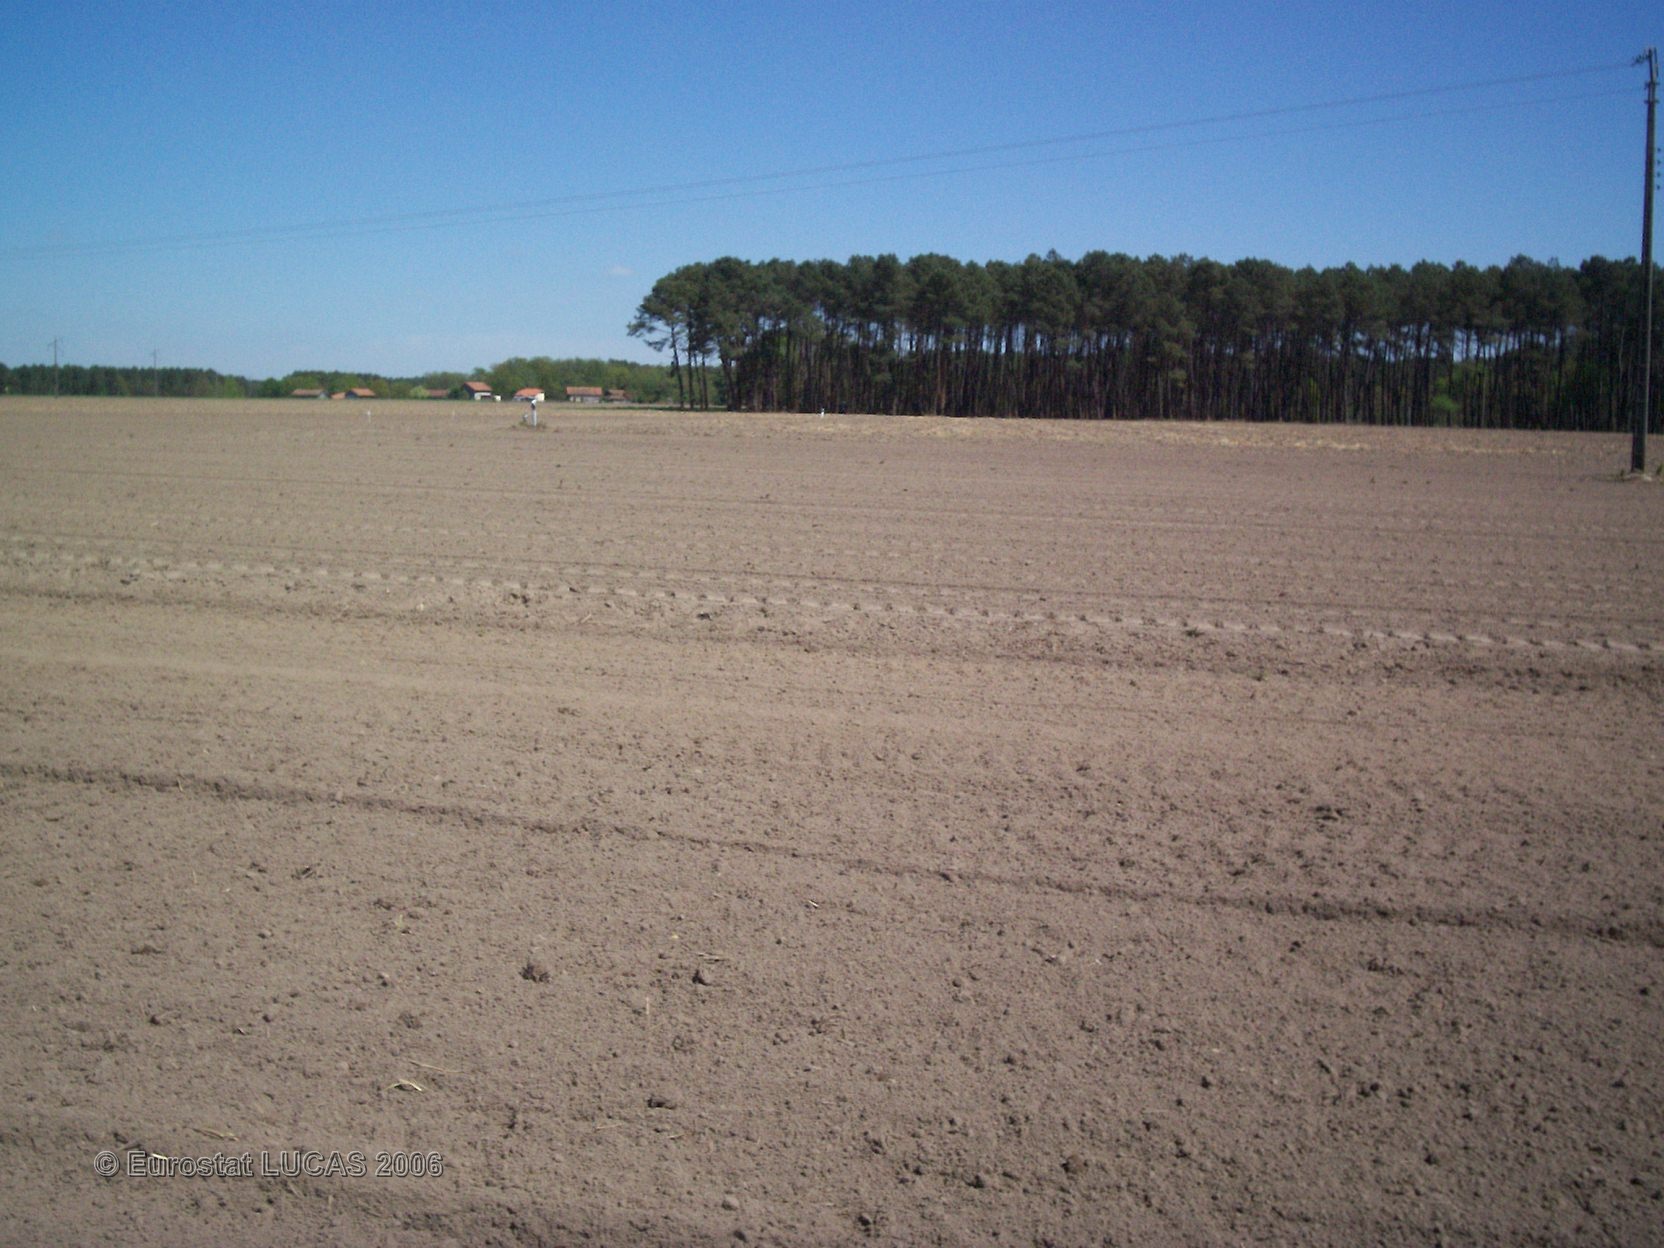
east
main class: Cropland
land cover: Maize
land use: Agriculture (excluding fallow land and kitchen gardens)
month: June
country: FR
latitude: 43.8300
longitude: -0.7203
